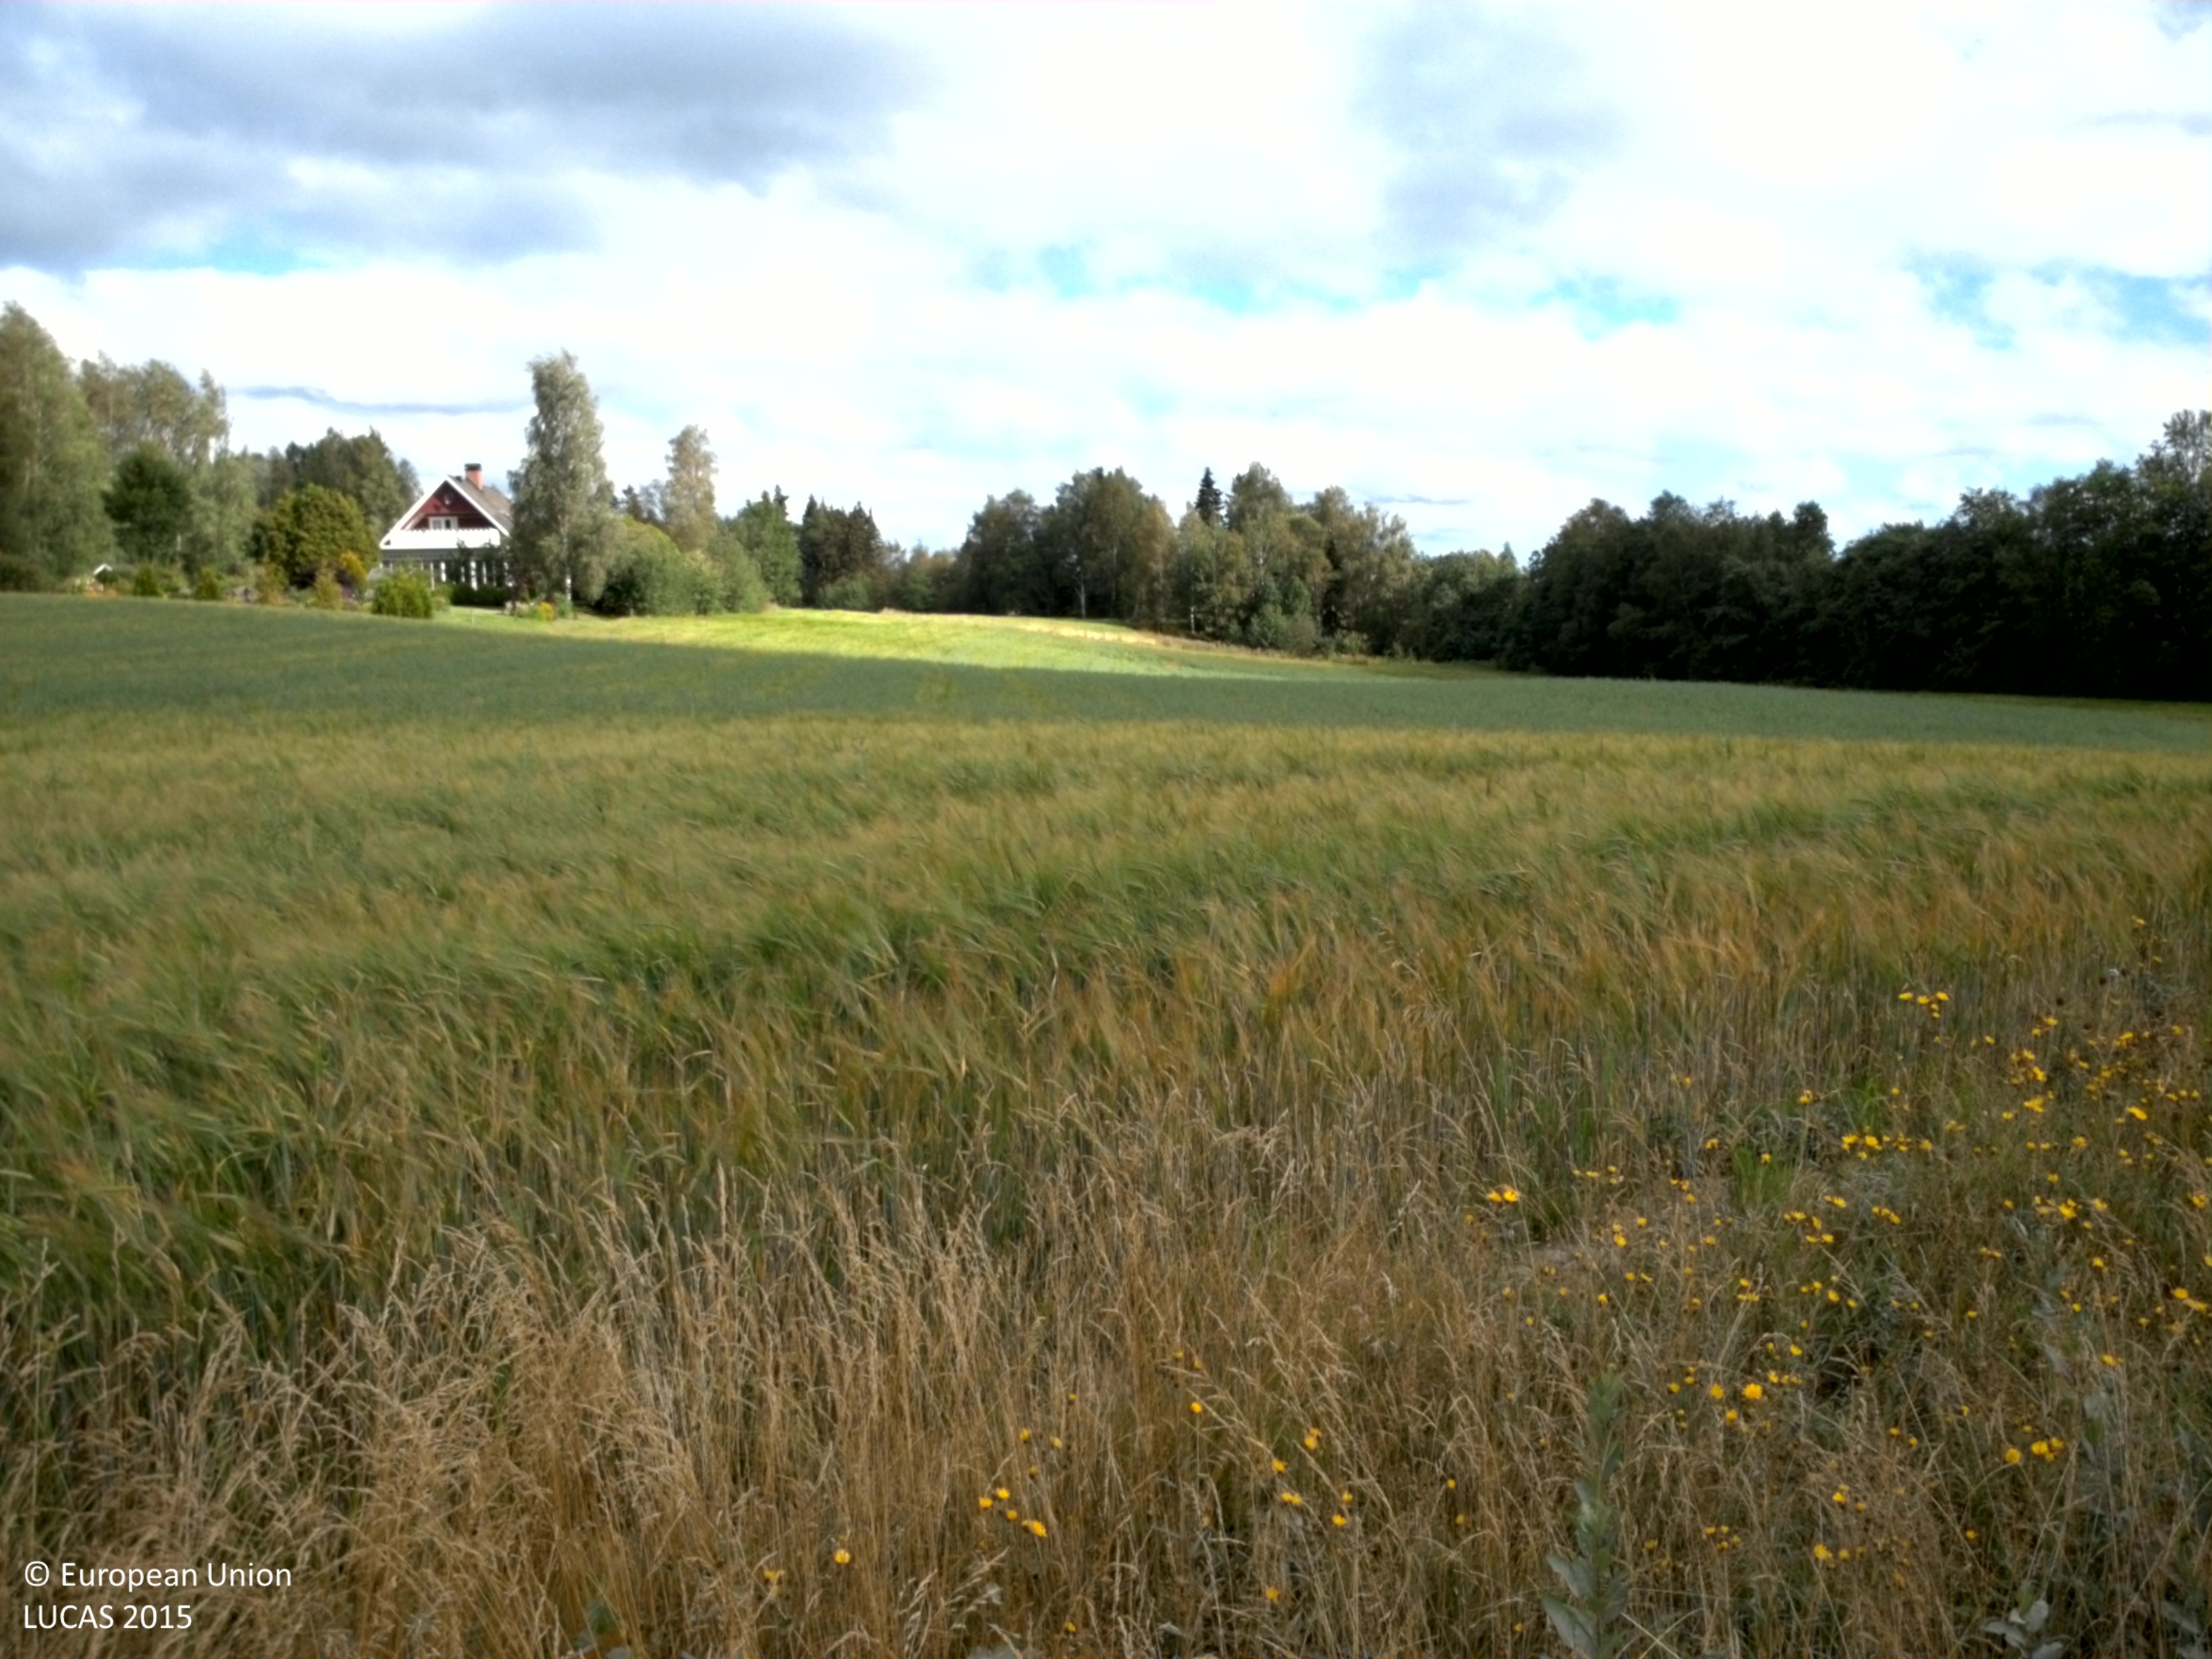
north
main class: Cropland
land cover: Mixed cereals for fodder
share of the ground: > 75 %
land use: Agriculture (excluding fallow land and kitchen gardens)
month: August
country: SE
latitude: 59.4639
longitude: 12.0239
